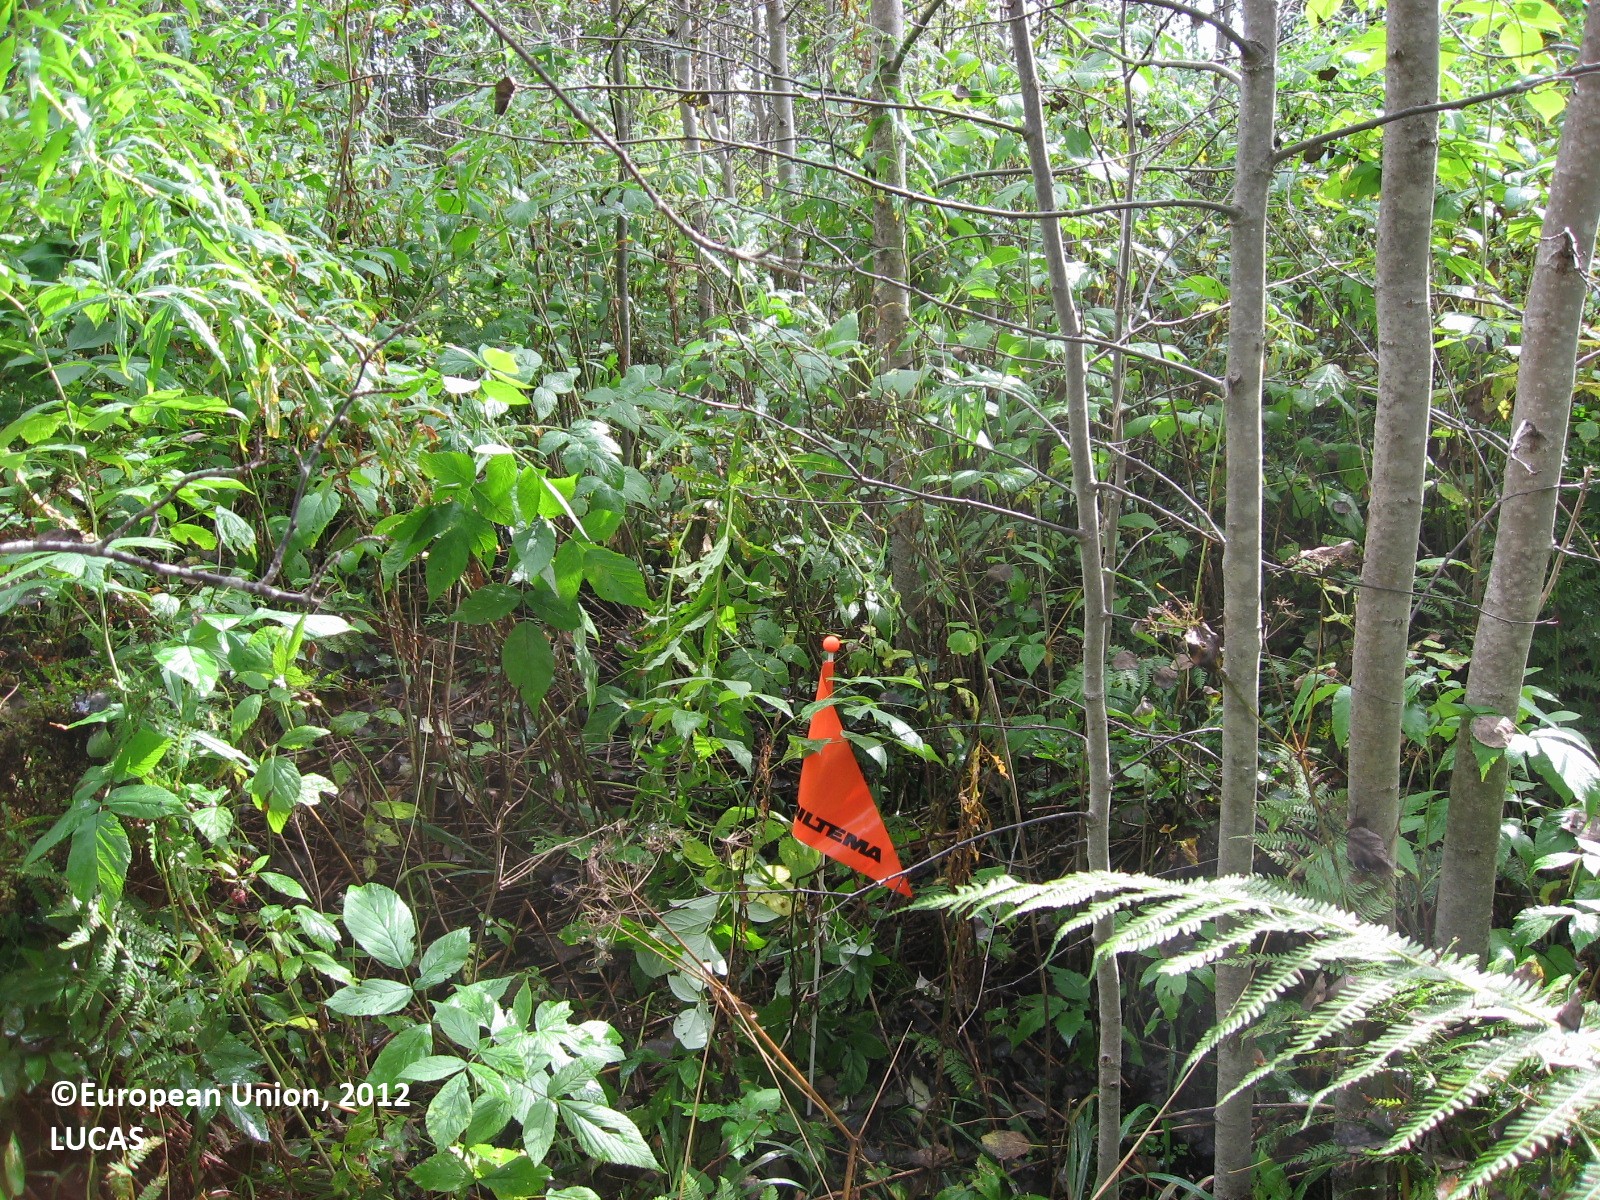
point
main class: Woodland
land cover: Broadleaved woodland
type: boreal forest
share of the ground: > 75 %
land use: Forestry
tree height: > 5 m
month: September
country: FI
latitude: 60.9459
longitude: 25.2378
